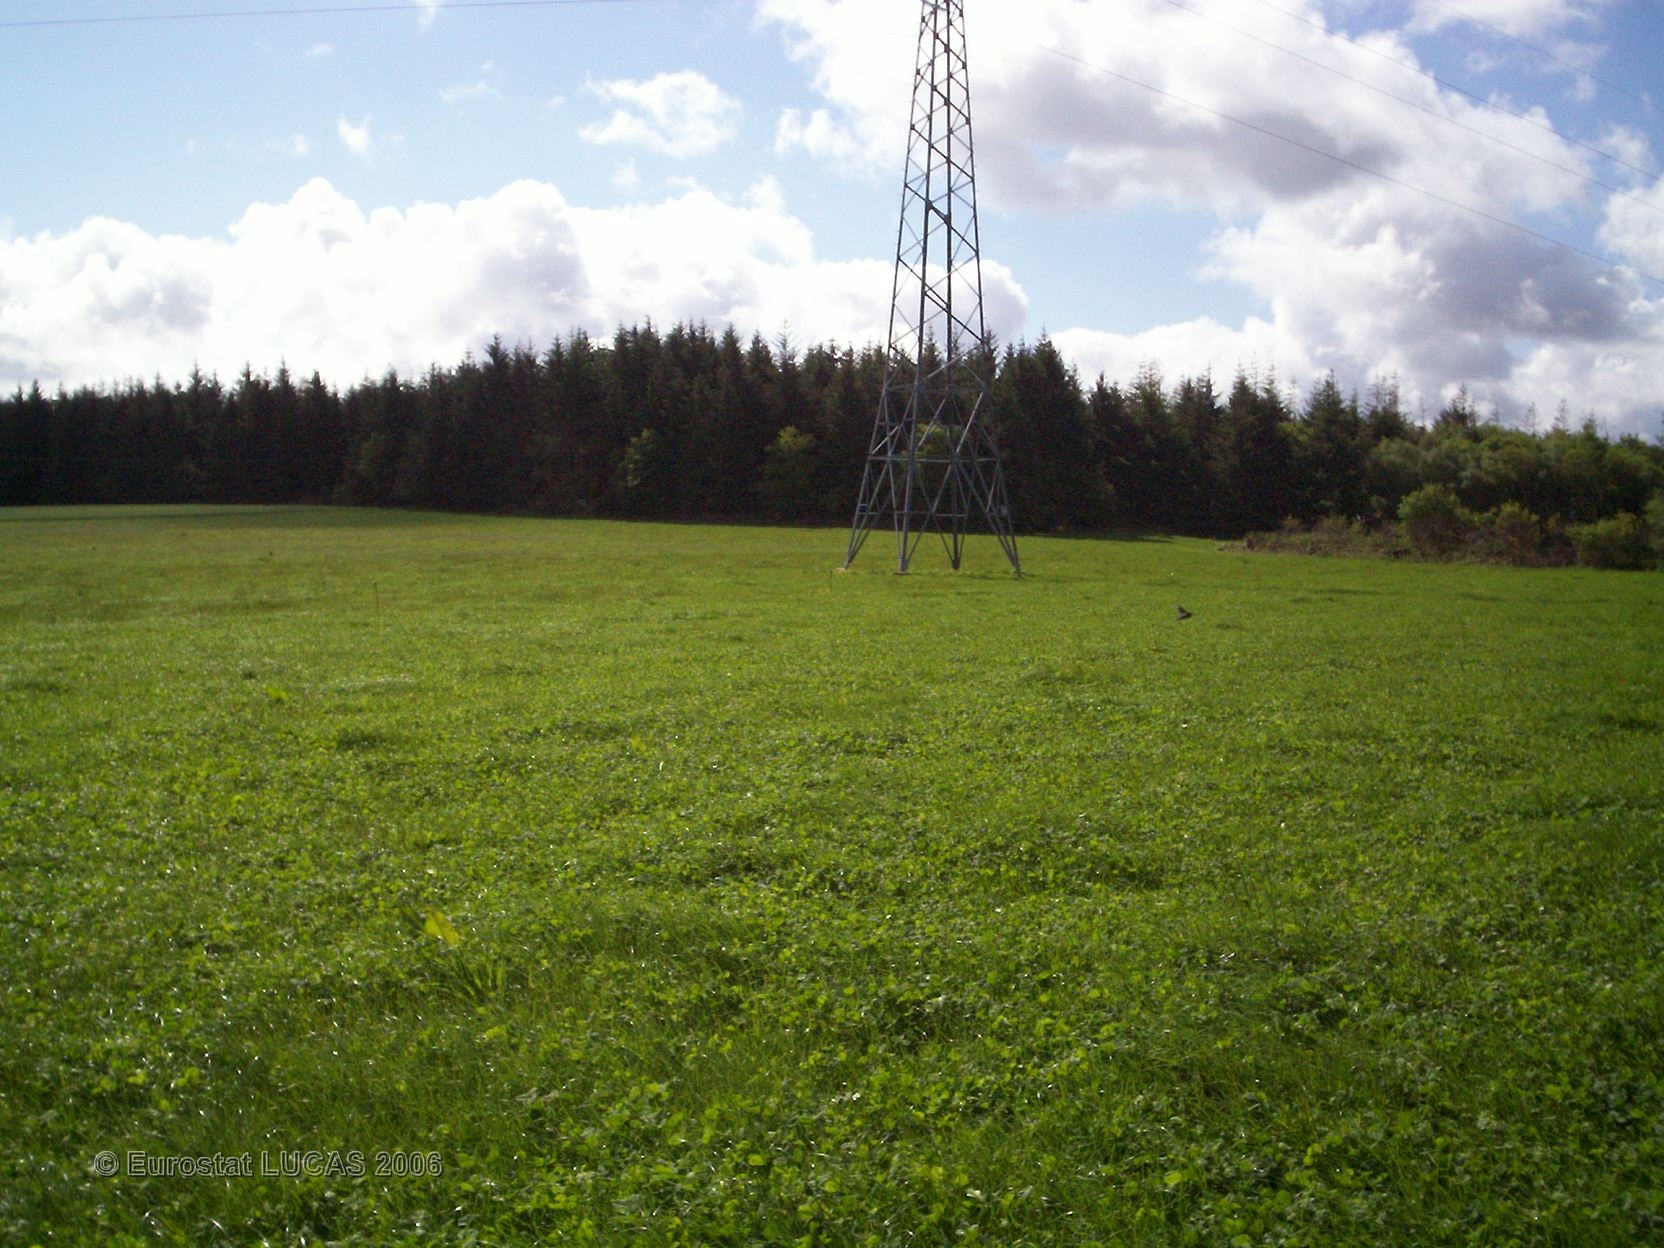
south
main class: Cropland
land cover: Clovers
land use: Agriculture (excluding fallow land and kitchen gardens)
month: May
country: FR
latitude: 48.2534
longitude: -2.9850
